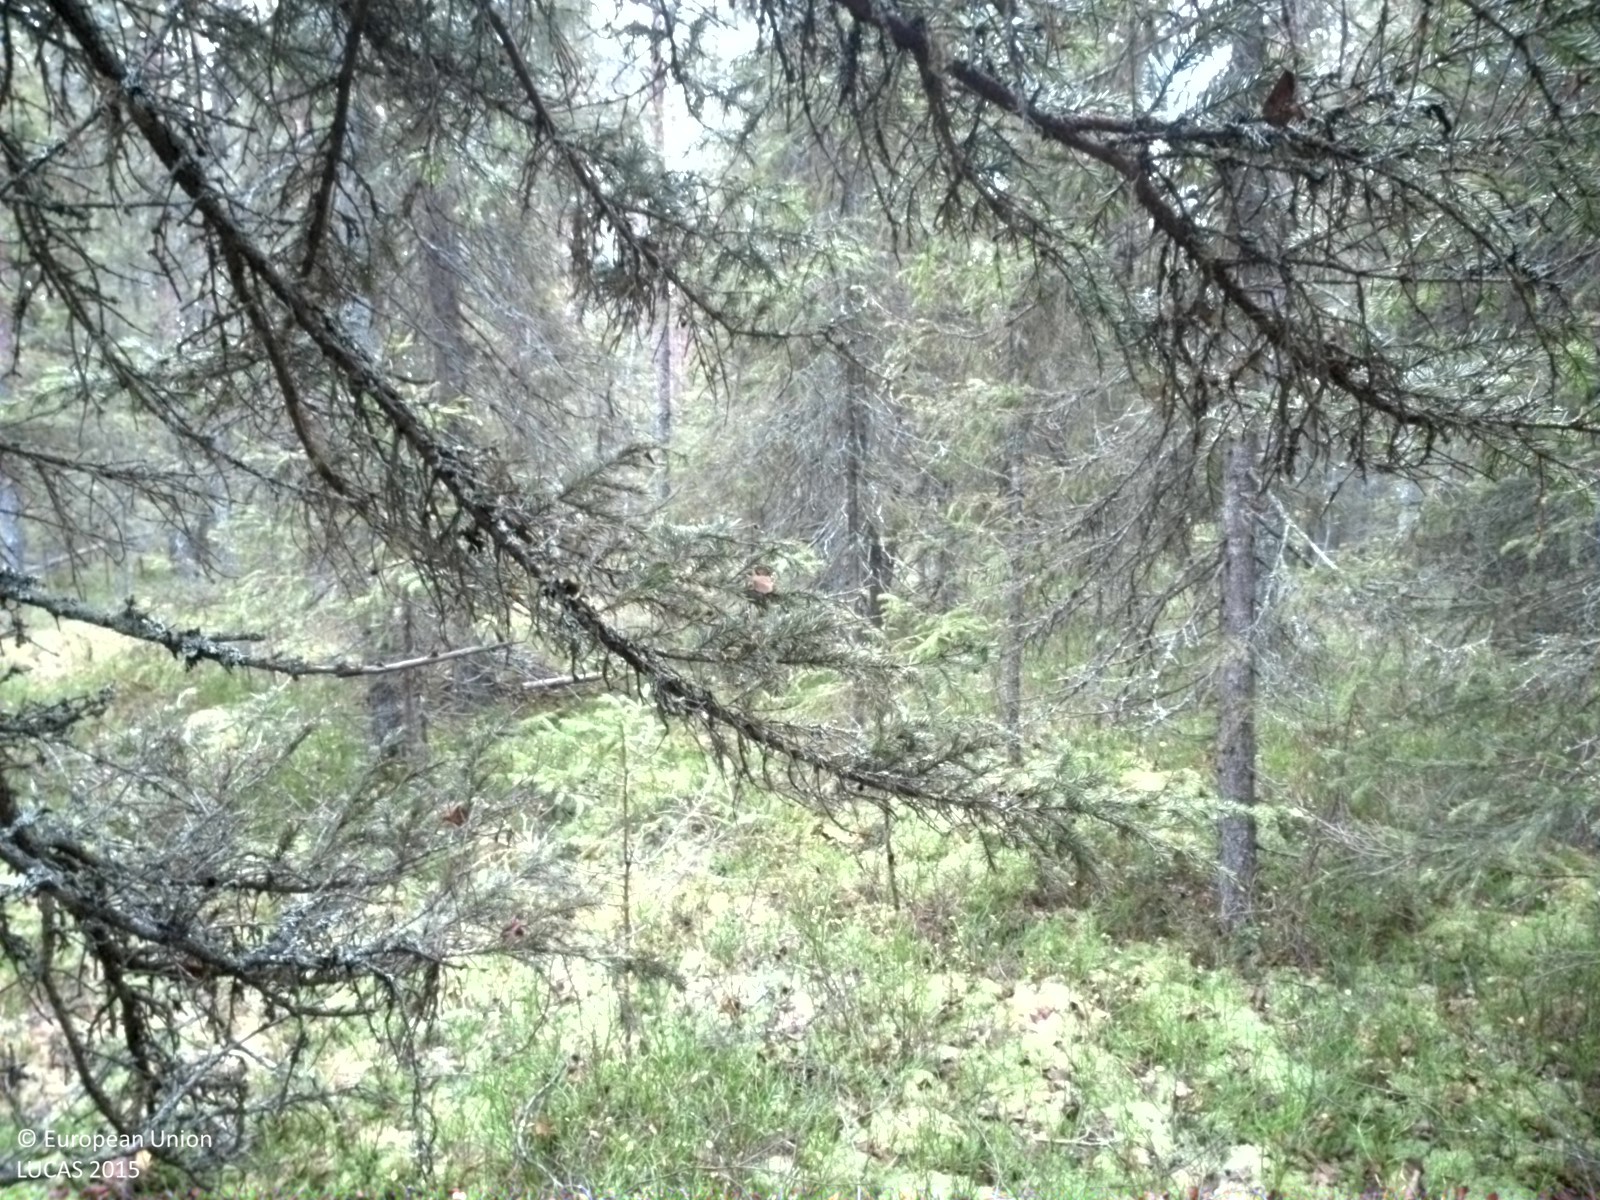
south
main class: Woodland
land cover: Other coniferous woodland
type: boreal forest
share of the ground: 50 - 75 %
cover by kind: coniferous forest trees 45 %, shrubs 45 %, broadleaved forest trees 5 %, lichens and mosses 5 %
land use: Forestry
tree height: > 5 m
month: October
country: SE
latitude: 66.0201
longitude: 22.3913
